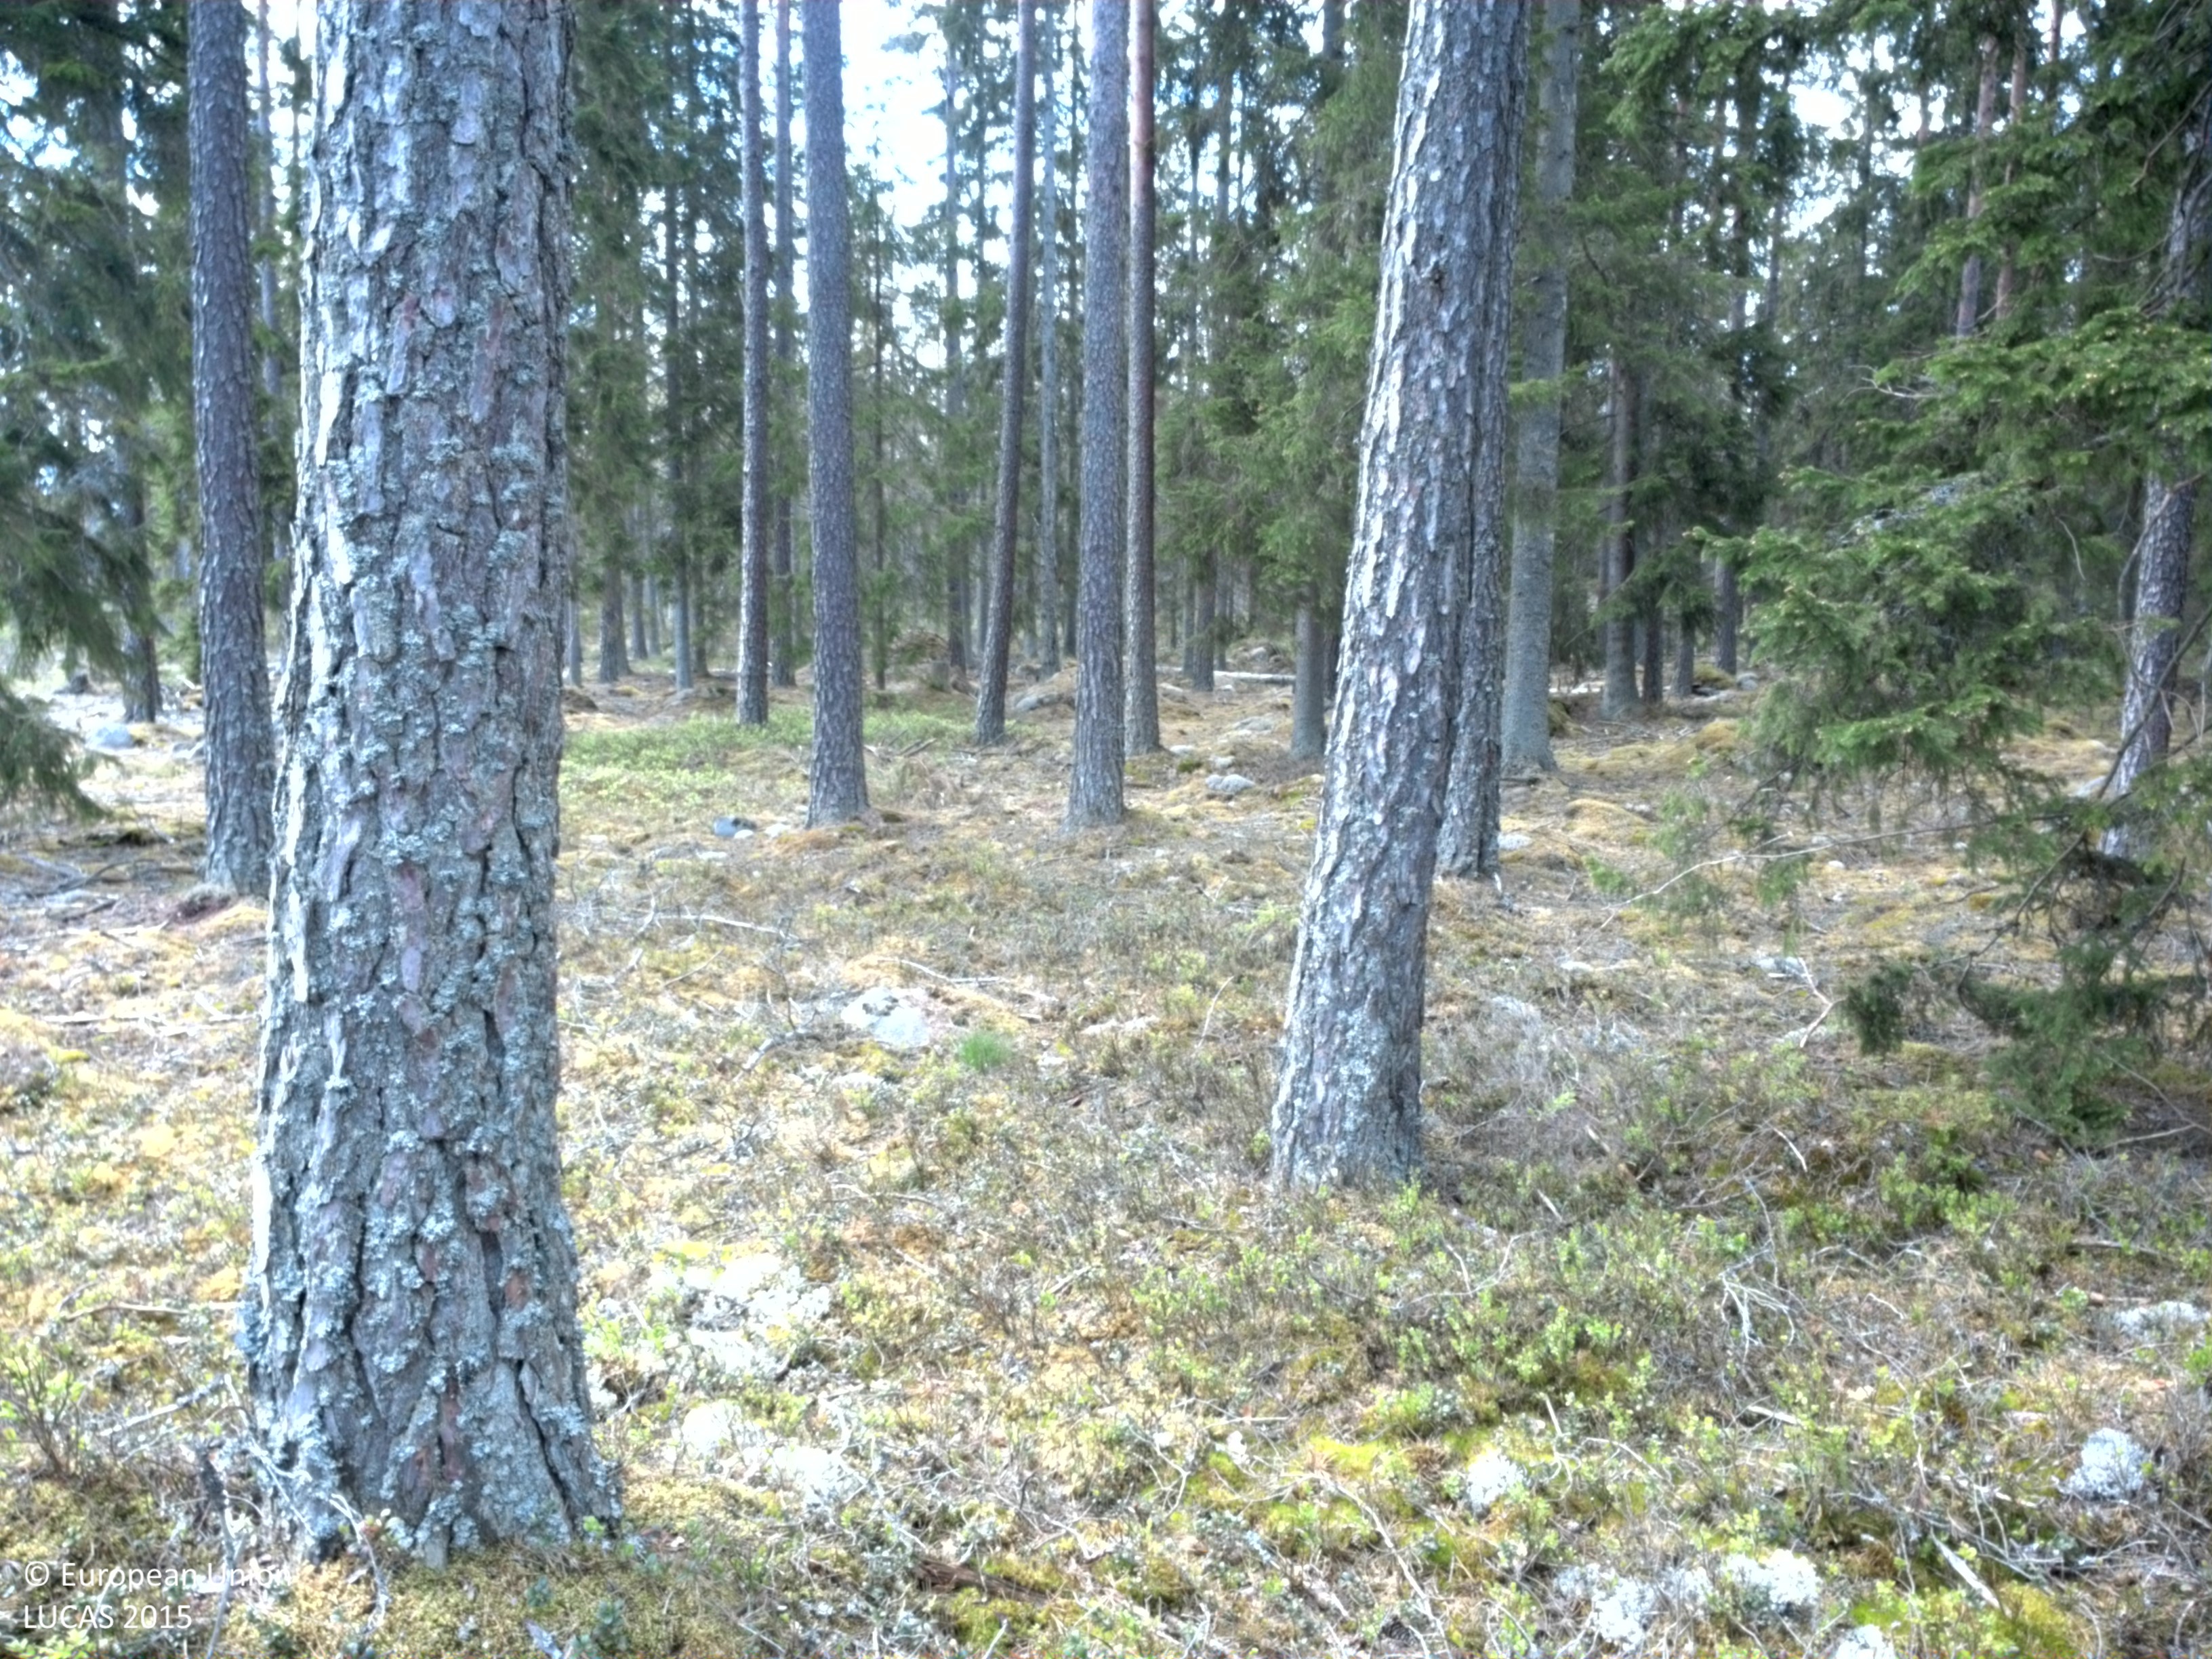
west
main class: Woodland
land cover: Pine dominated coniferous woodland
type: boreal forest
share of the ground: 50 - 75 %
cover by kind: coniferous forest trees 40 %, shrubs 35 %, lichens and mosses 15 %, broadleaved forest trees 10 %
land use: Forestry
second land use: Amenities, museums, leisure
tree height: > 5 m
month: May
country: SE
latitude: 56.8229
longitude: 15.1590
